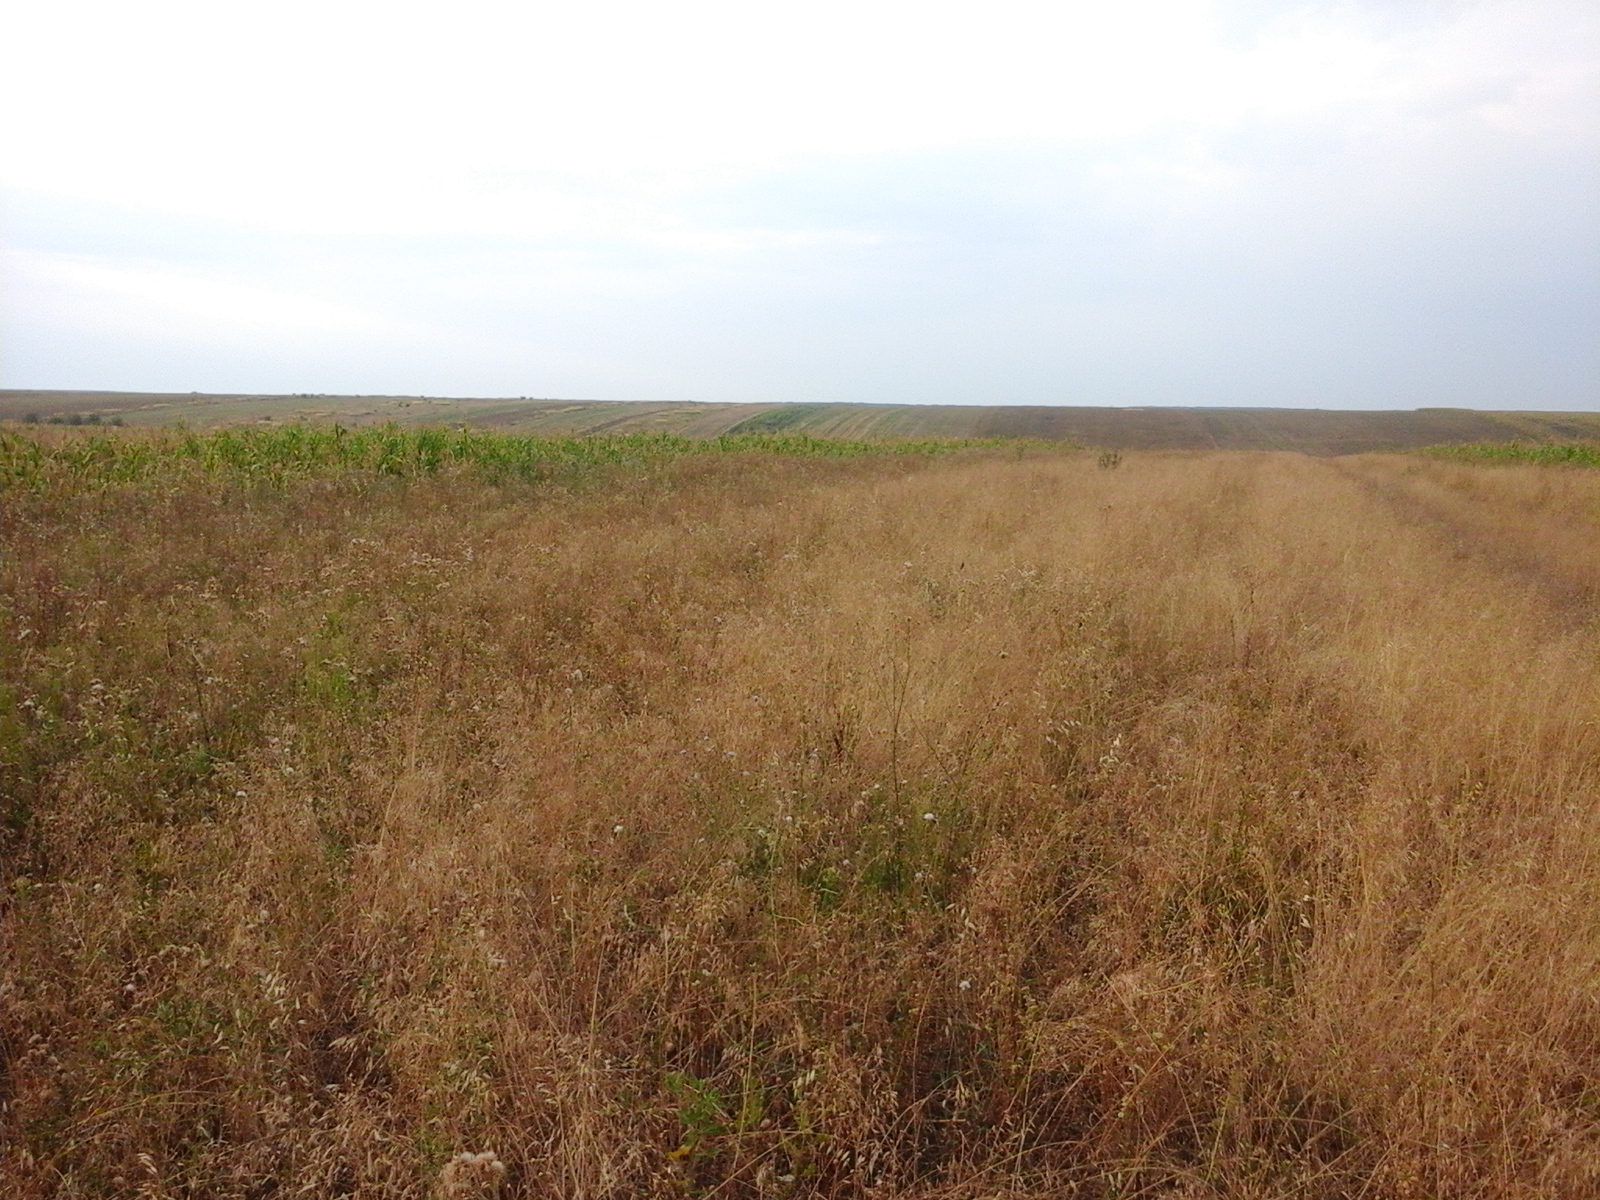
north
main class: Grassland
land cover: Grassland without tree/shrub cover
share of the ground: > 75 %
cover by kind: herbaceous plants 100 %
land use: Agriculture (excluding fallow land and kitchen gardens)
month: August
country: RO
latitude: 44.3858
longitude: 23.2919
